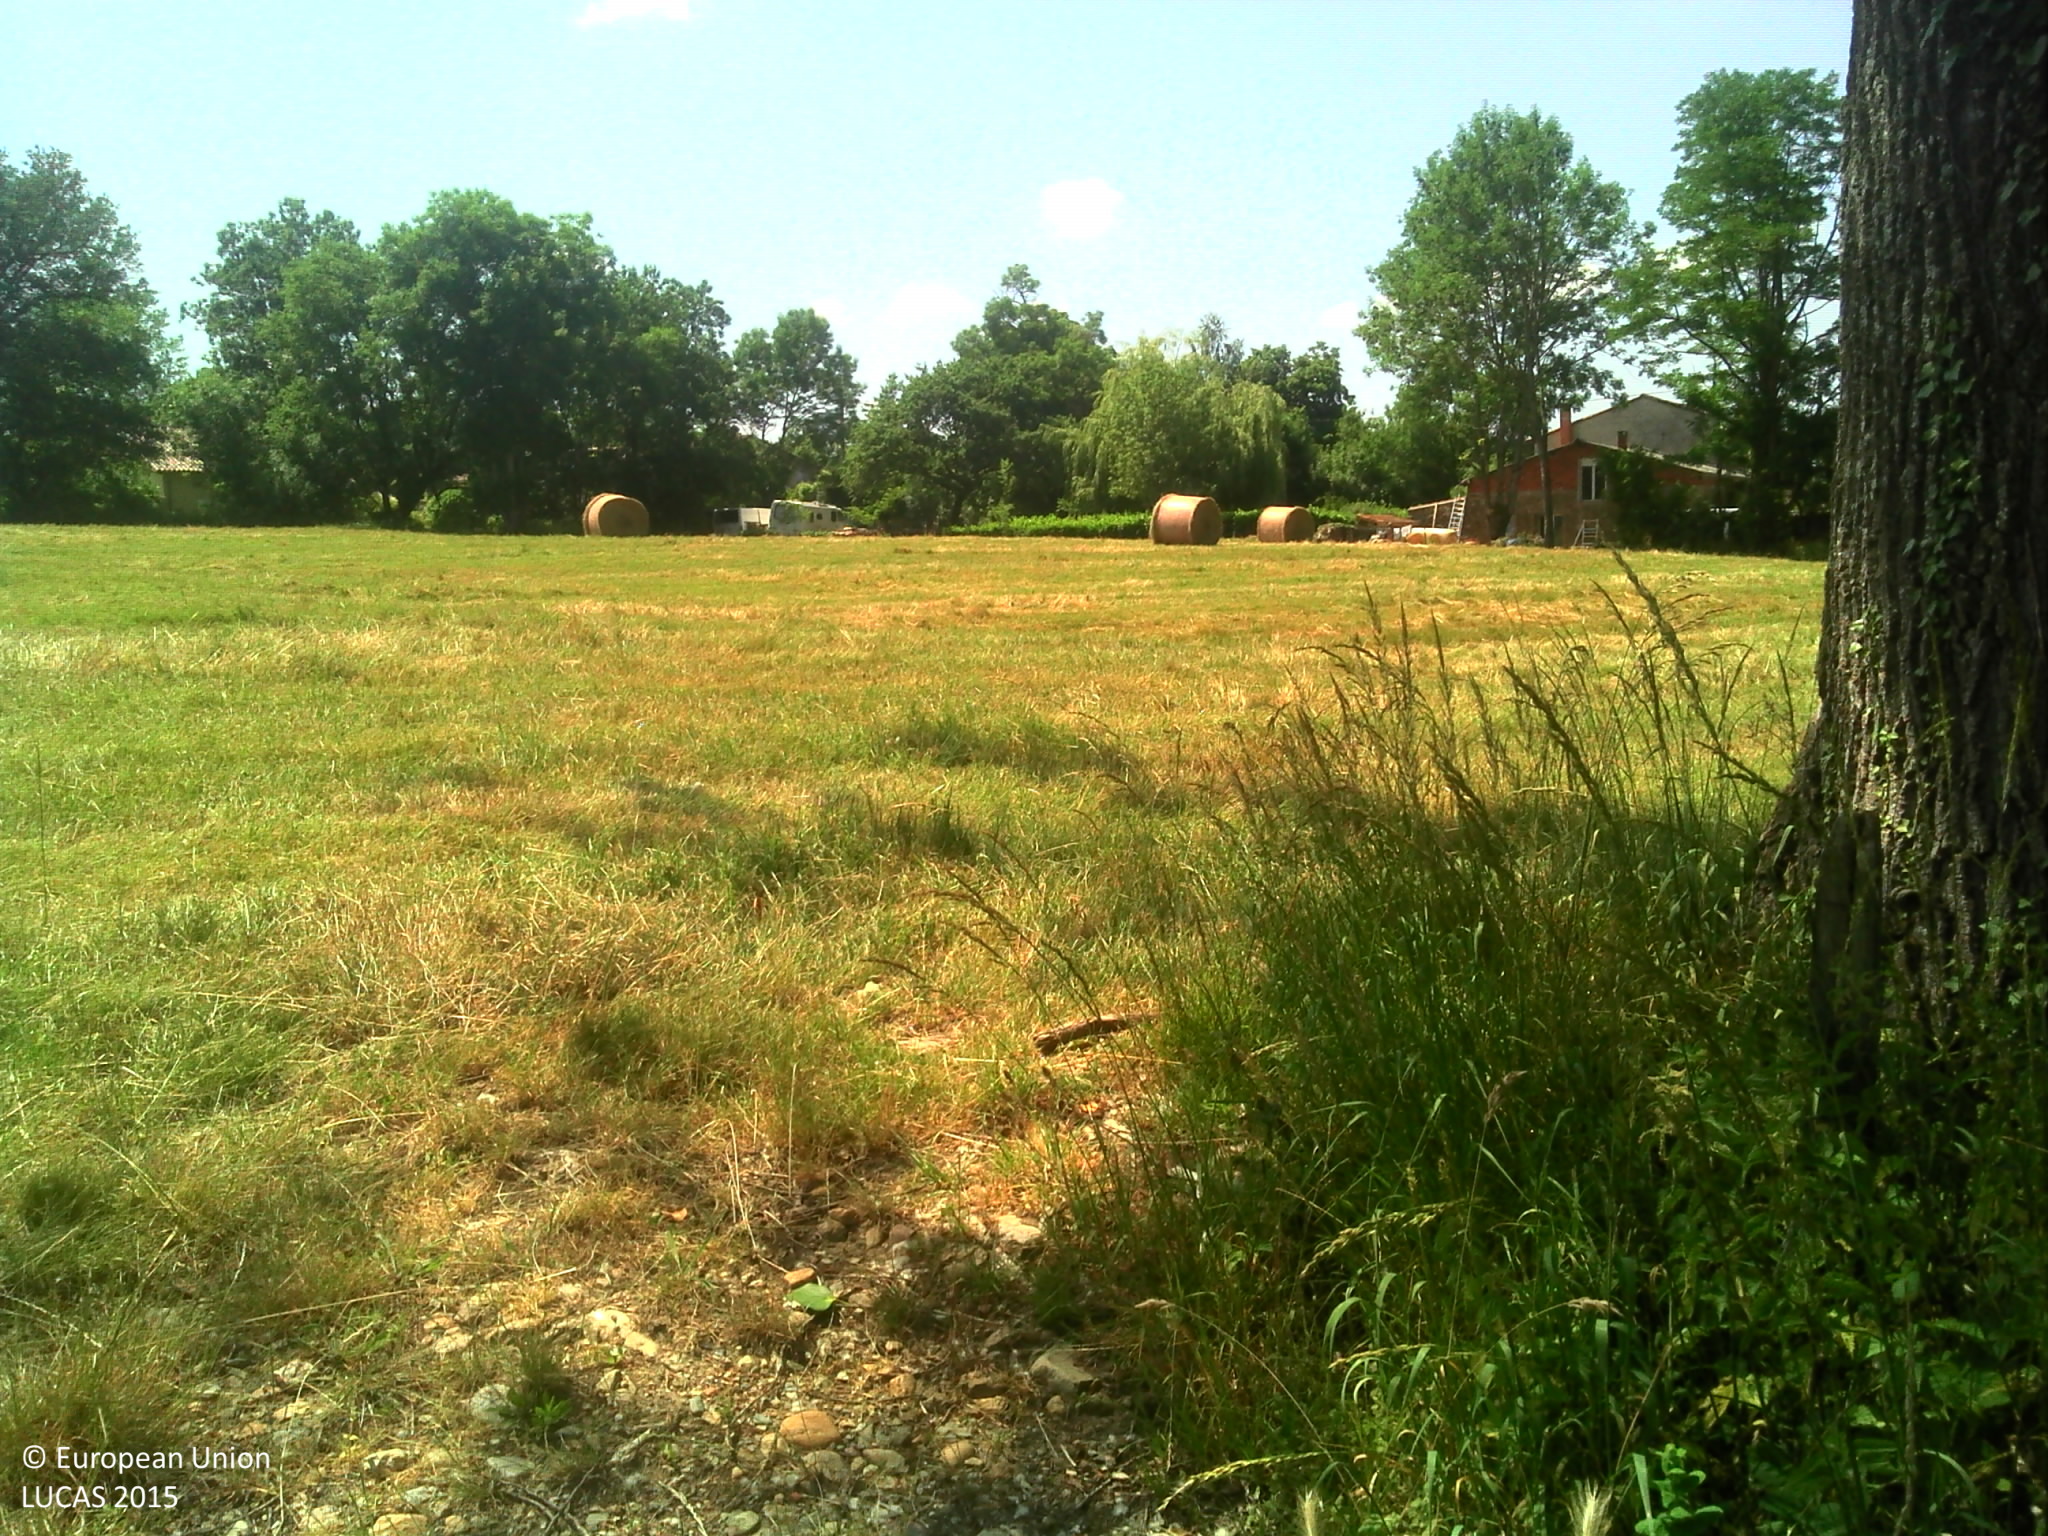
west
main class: Grassland
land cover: Grassland without tree/shrub cover
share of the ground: > 75 %
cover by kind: herbaceous plants 100 %
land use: Agriculture (excluding fallow land and kitchen gardens)
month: June
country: FR
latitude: 43.5274
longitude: 2.1489
